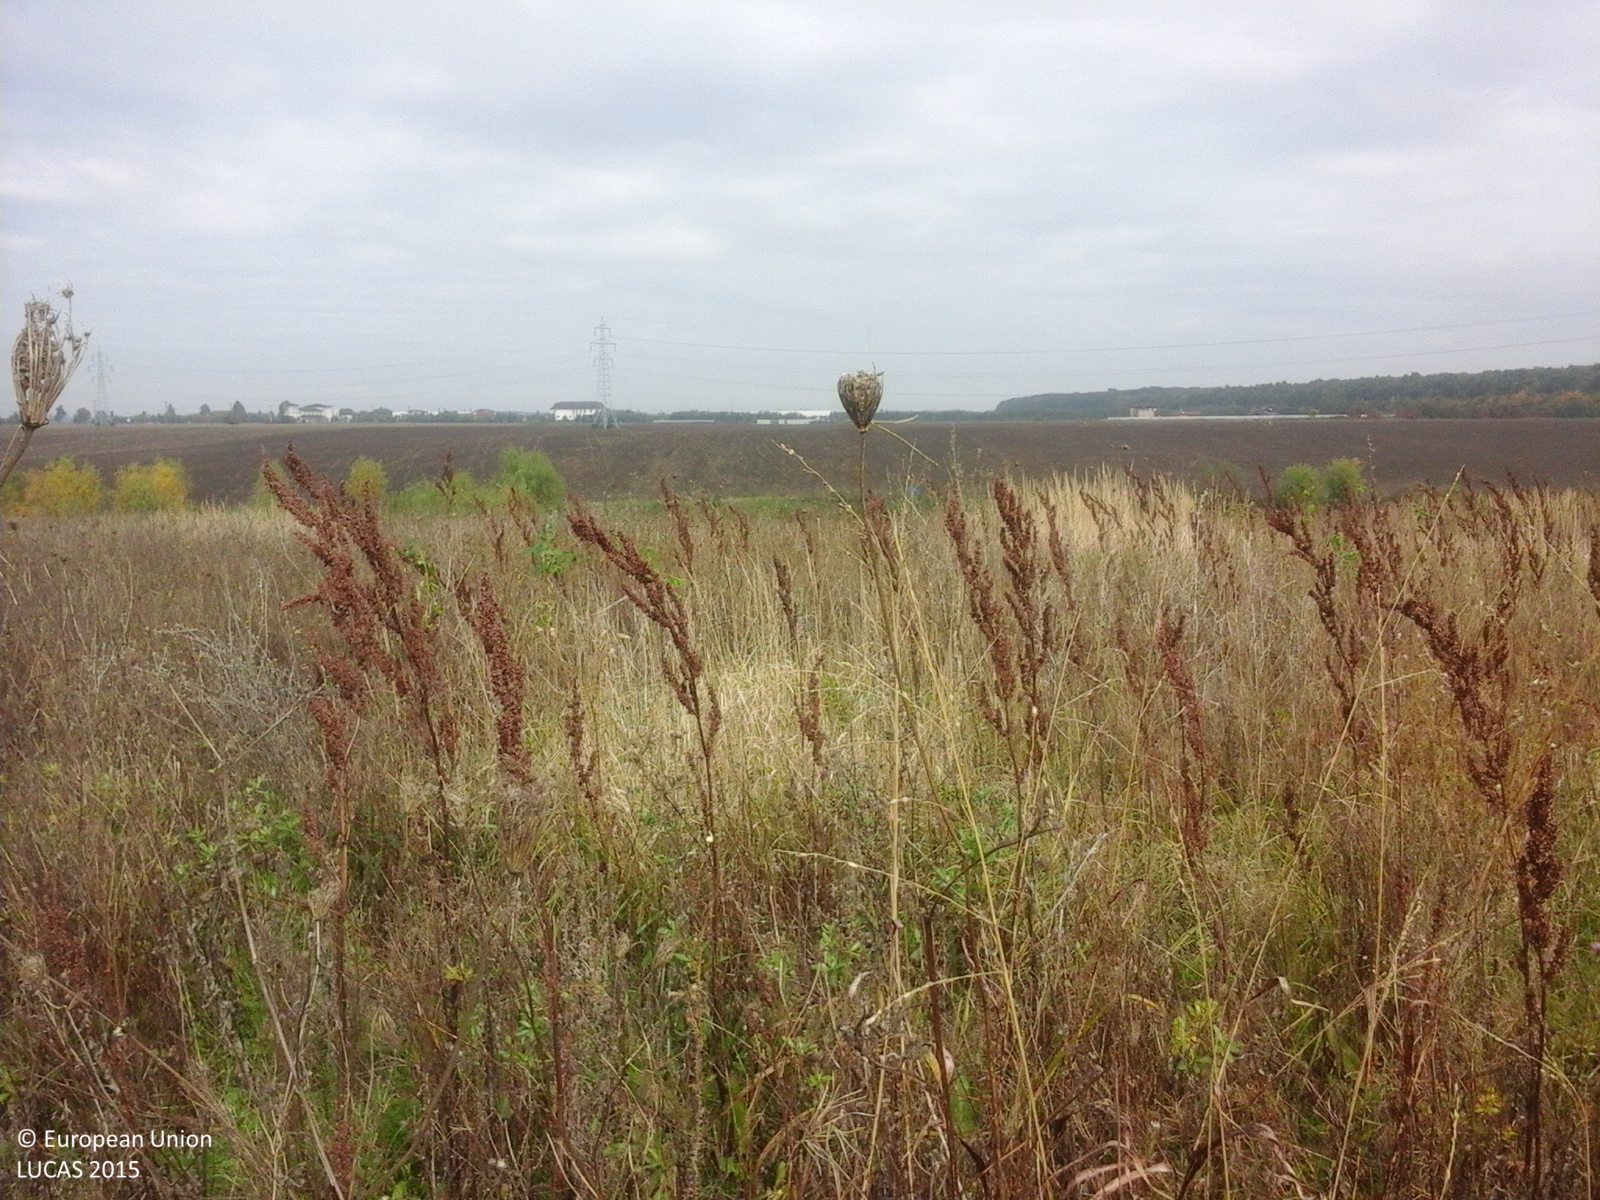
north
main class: Grassland
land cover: Spontaneously vegetated surfaces
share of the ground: > 75 %
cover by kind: herbaceous plants 100 %
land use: Fallow land
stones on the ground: < 10 %
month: October
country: RO
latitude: 44.6469
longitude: 26.0820
